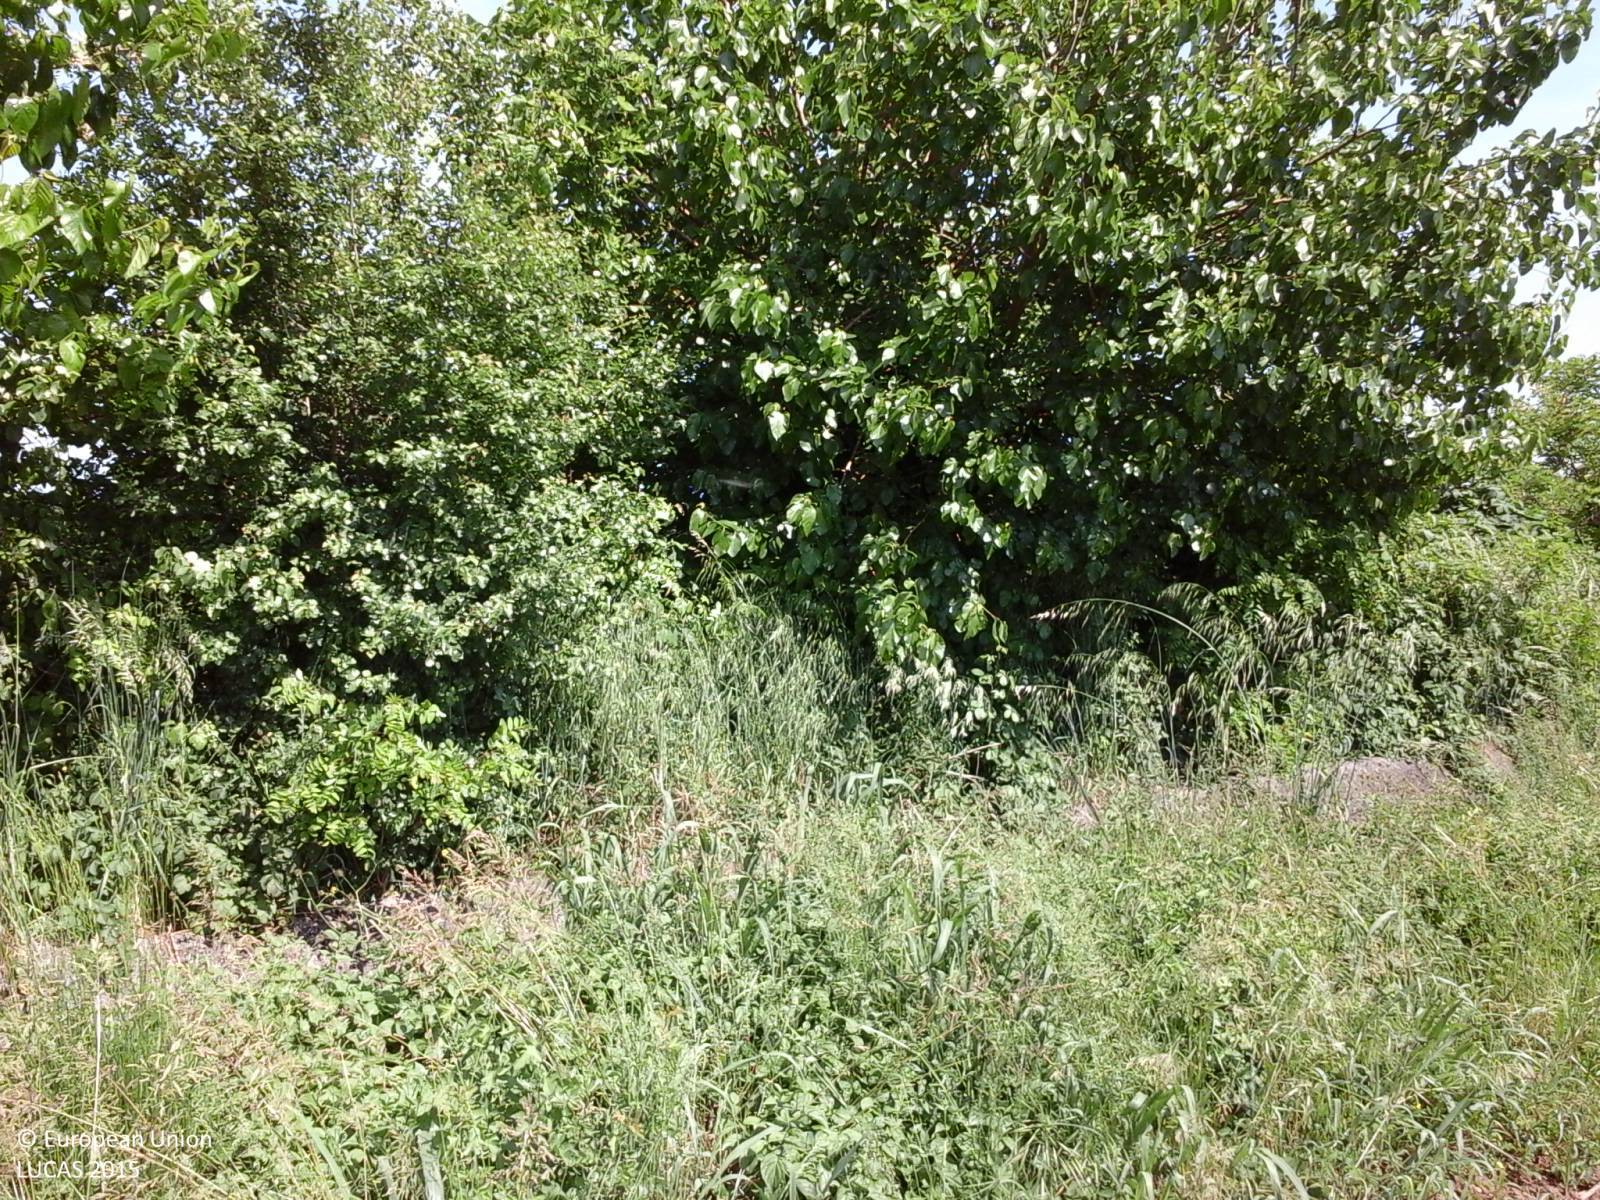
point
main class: Woodland
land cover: Broadleaved woodland
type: thermophilous deciduous forest
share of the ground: > 75 %
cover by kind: broadleaved forest trees 90 %, shrubs 10 %
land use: Forestry
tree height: > 5 m
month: May
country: IT
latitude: 45.9050
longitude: 13.2574
